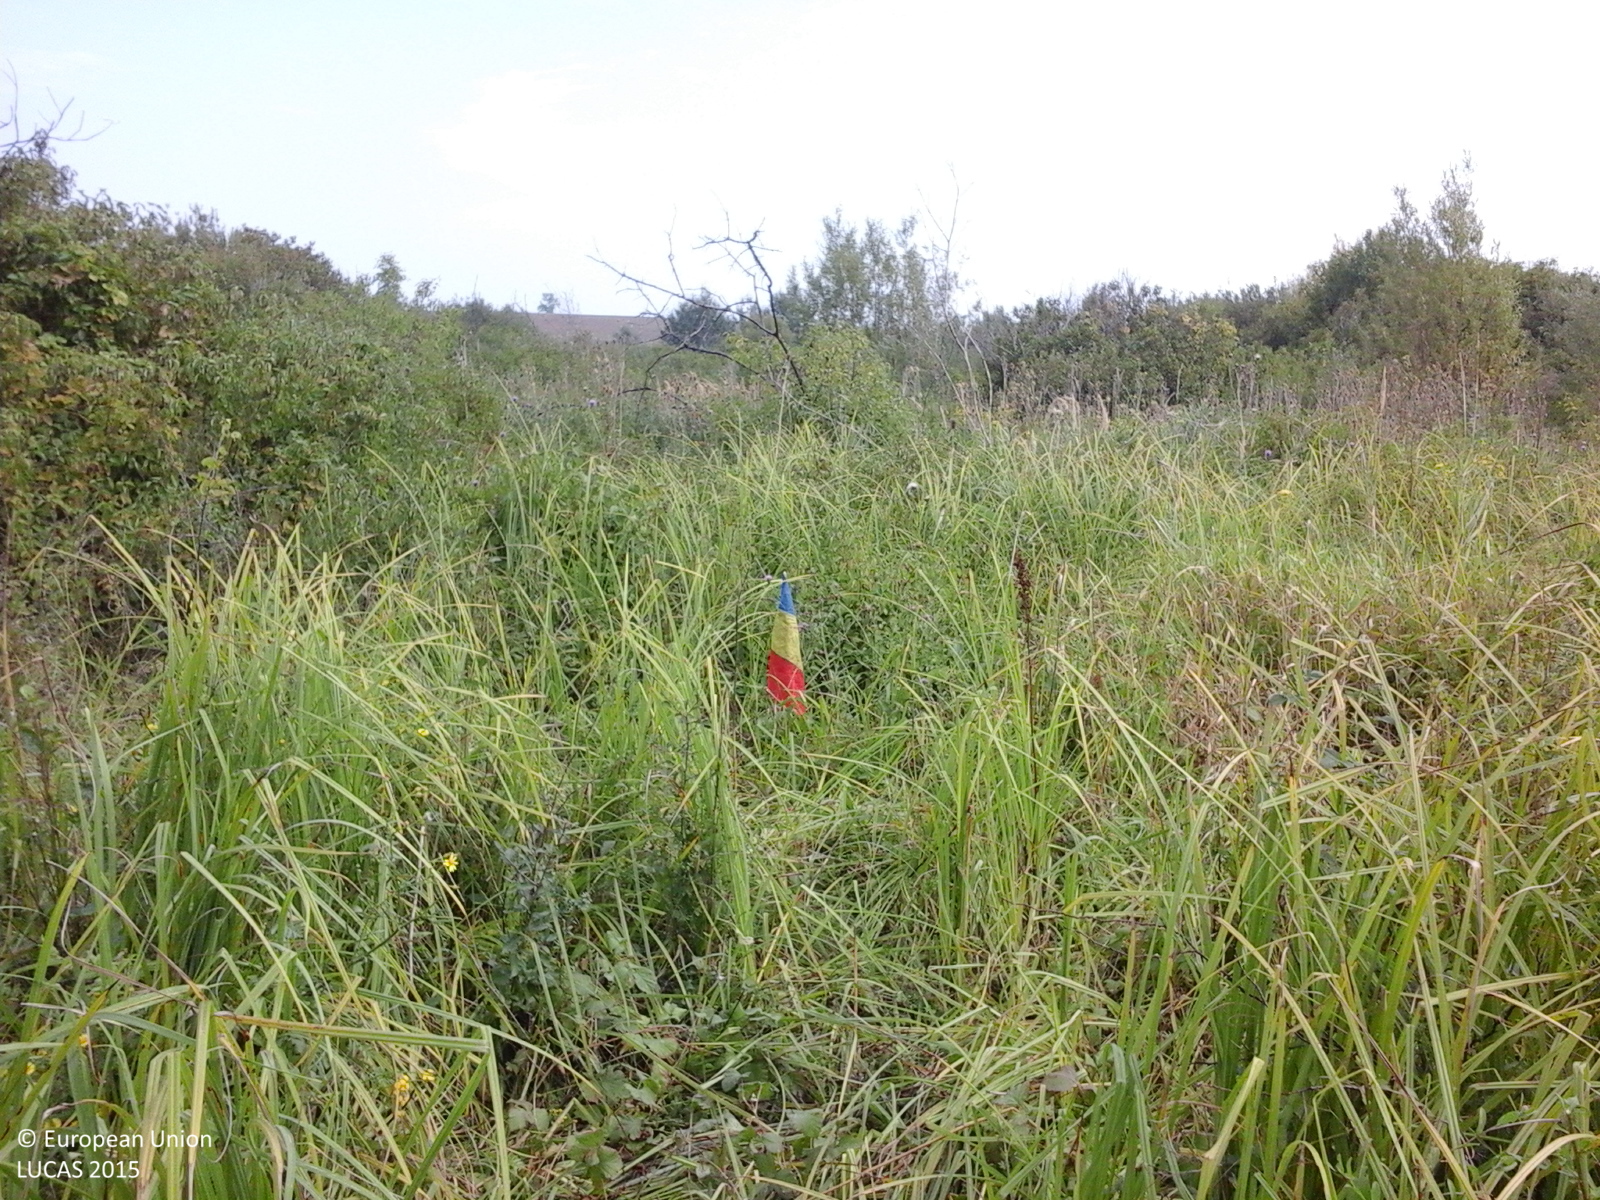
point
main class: Shrubland
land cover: Shrubland with sparse tree cover
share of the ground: > 75 %
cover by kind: herbaceous plants 85 %, shrubs 10 %, broadleaved forest trees 5 %
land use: Semi-natural and natural areas not in use
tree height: < 5 m
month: August
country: RO
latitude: 46.0710
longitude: 21.5297
